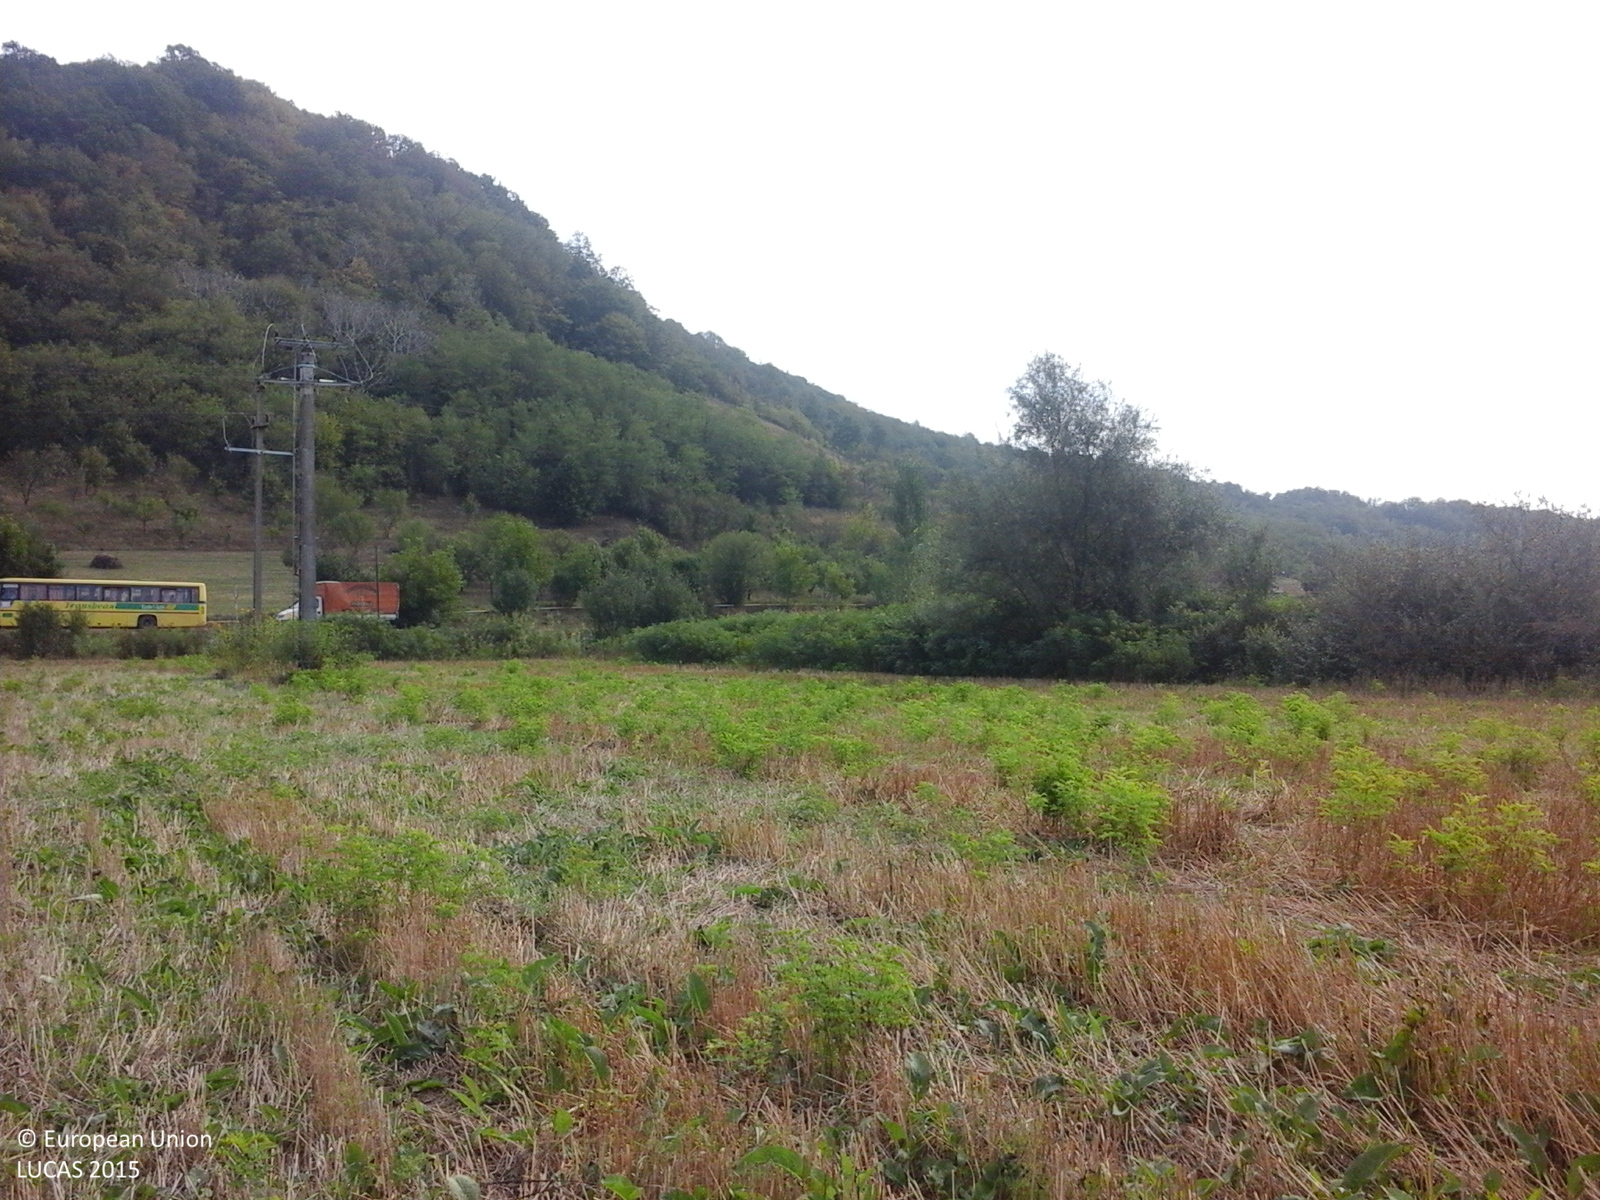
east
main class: Cropland
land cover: Oats
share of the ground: 25 - 50 %
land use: Agriculture (excluding fallow land and kitchen gardens)
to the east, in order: Oats; Spontaneously vegetated surfaces; Electric lines; Oats; Electric lines; Oats; Shrubland without tree cover; Maize; Spontaneously vegetated surfaces; Electric lines; Spontaneously vegetated surfaces; Grass margins; Paved roads, cycling and walking lanes; Grass margins; Ditches and canals; Other fruit trees and berries; Spontaneously vegetated surfaces; Broadleaved woodland
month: September
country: RO
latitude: 47.2781
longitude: 23.6519
